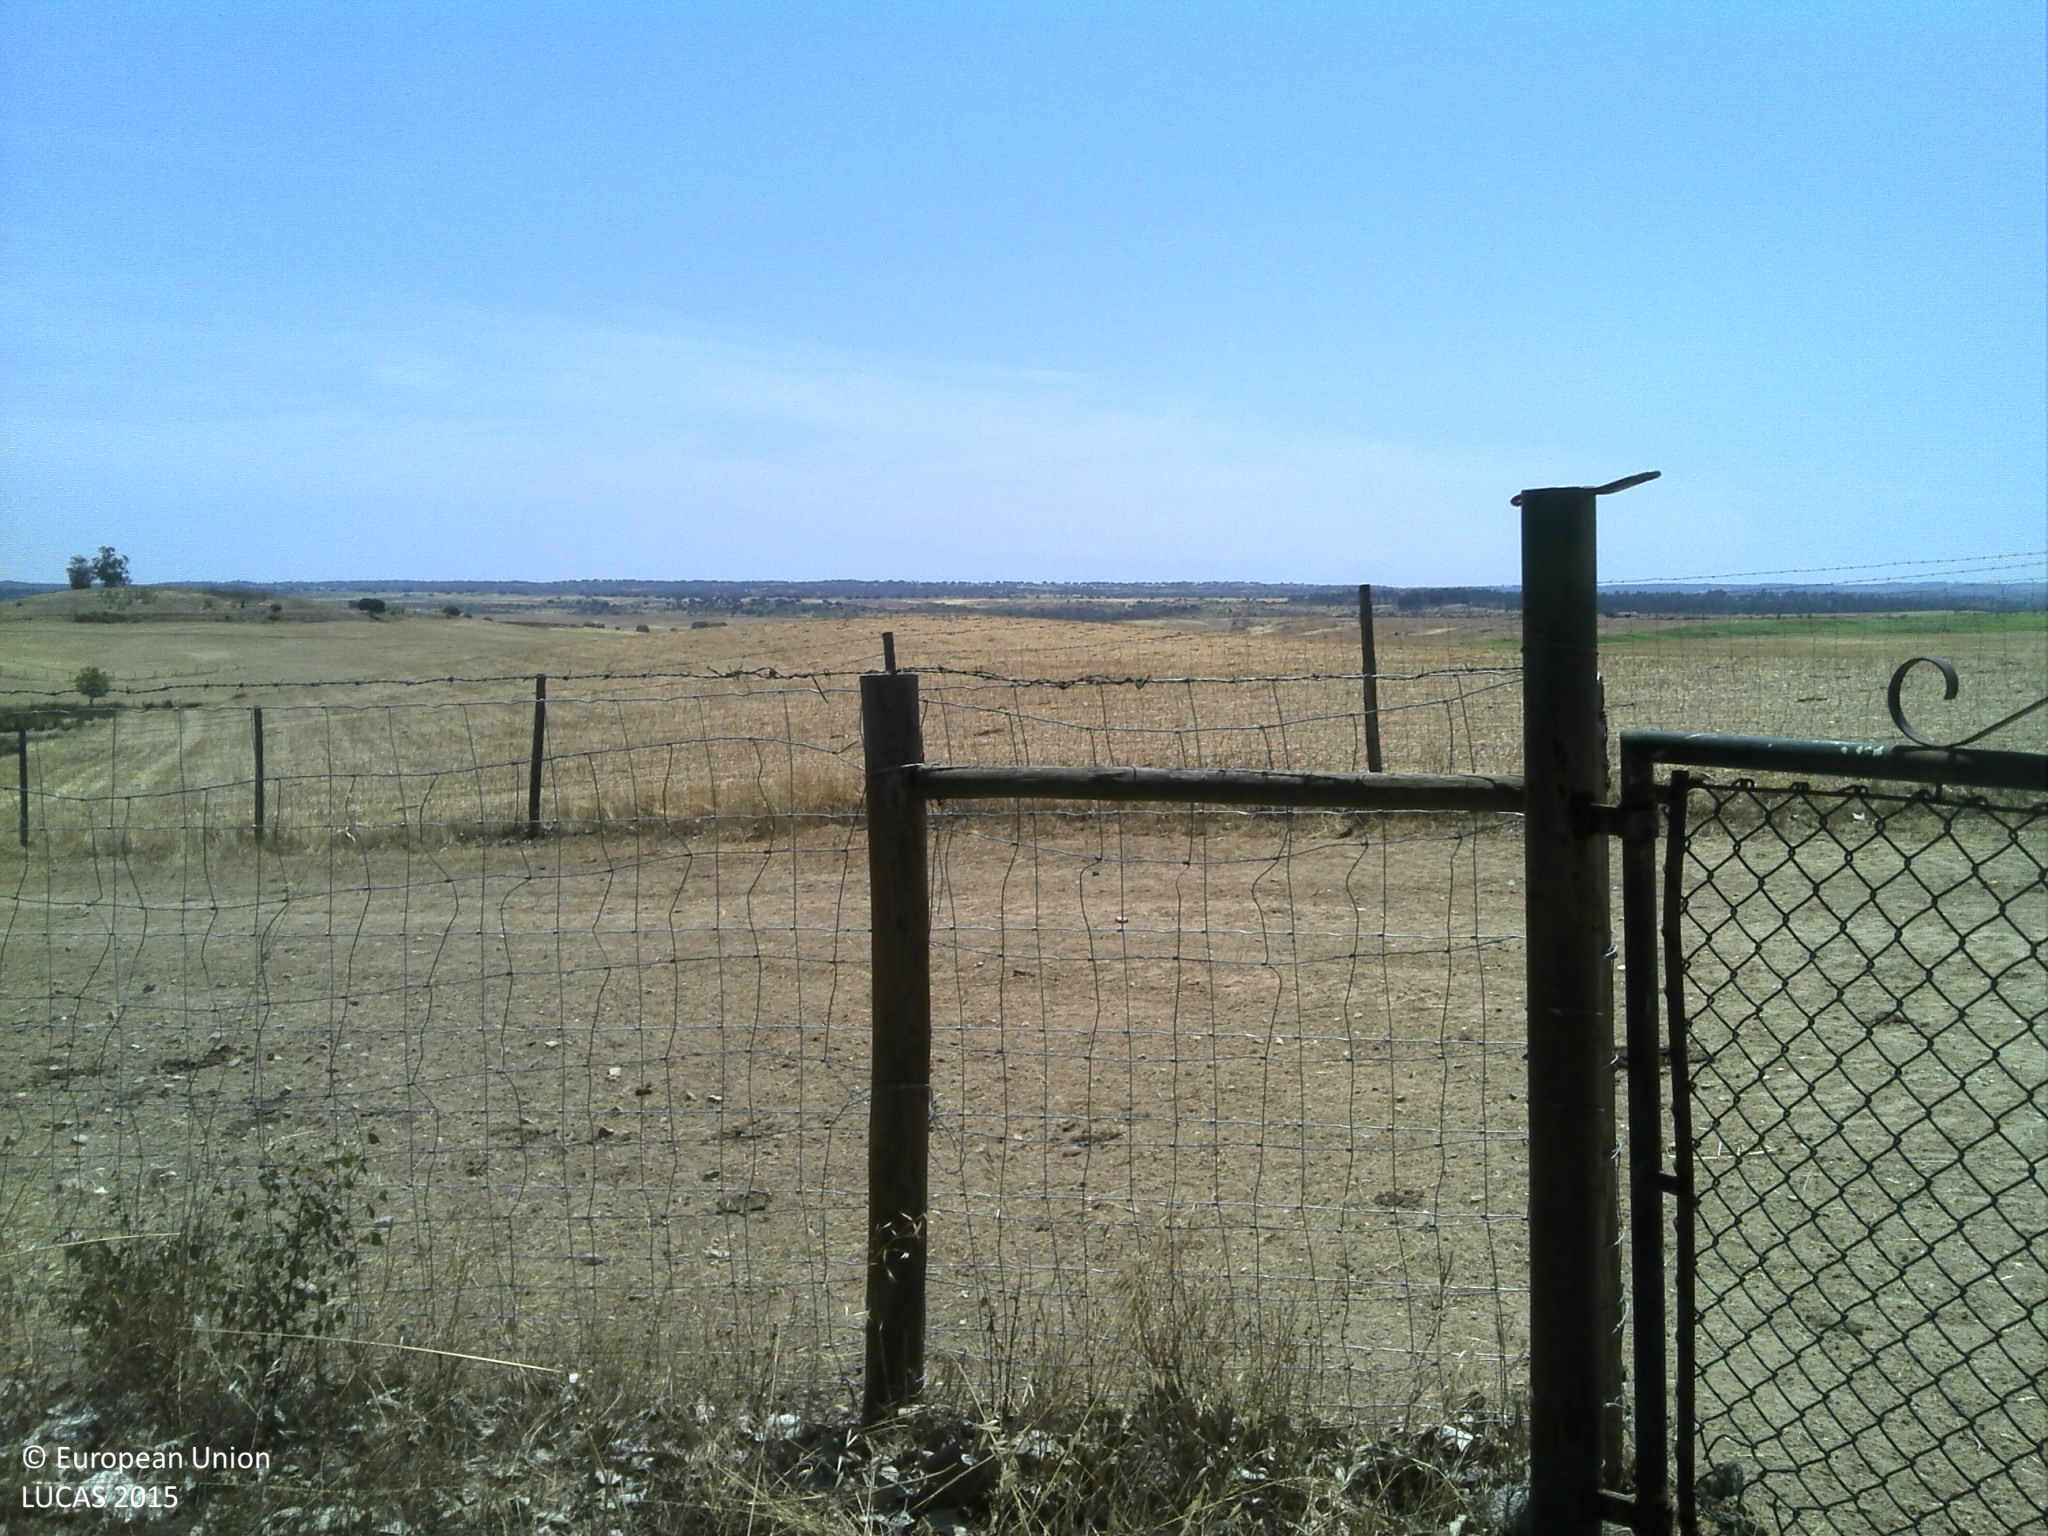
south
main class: Cropland
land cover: Arable land (only in case pi)
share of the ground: 50 - 75 %
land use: Agriculture (excluding fallow land and kitchen gardens)
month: June
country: PT
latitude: 39.8265
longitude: -7.1851
